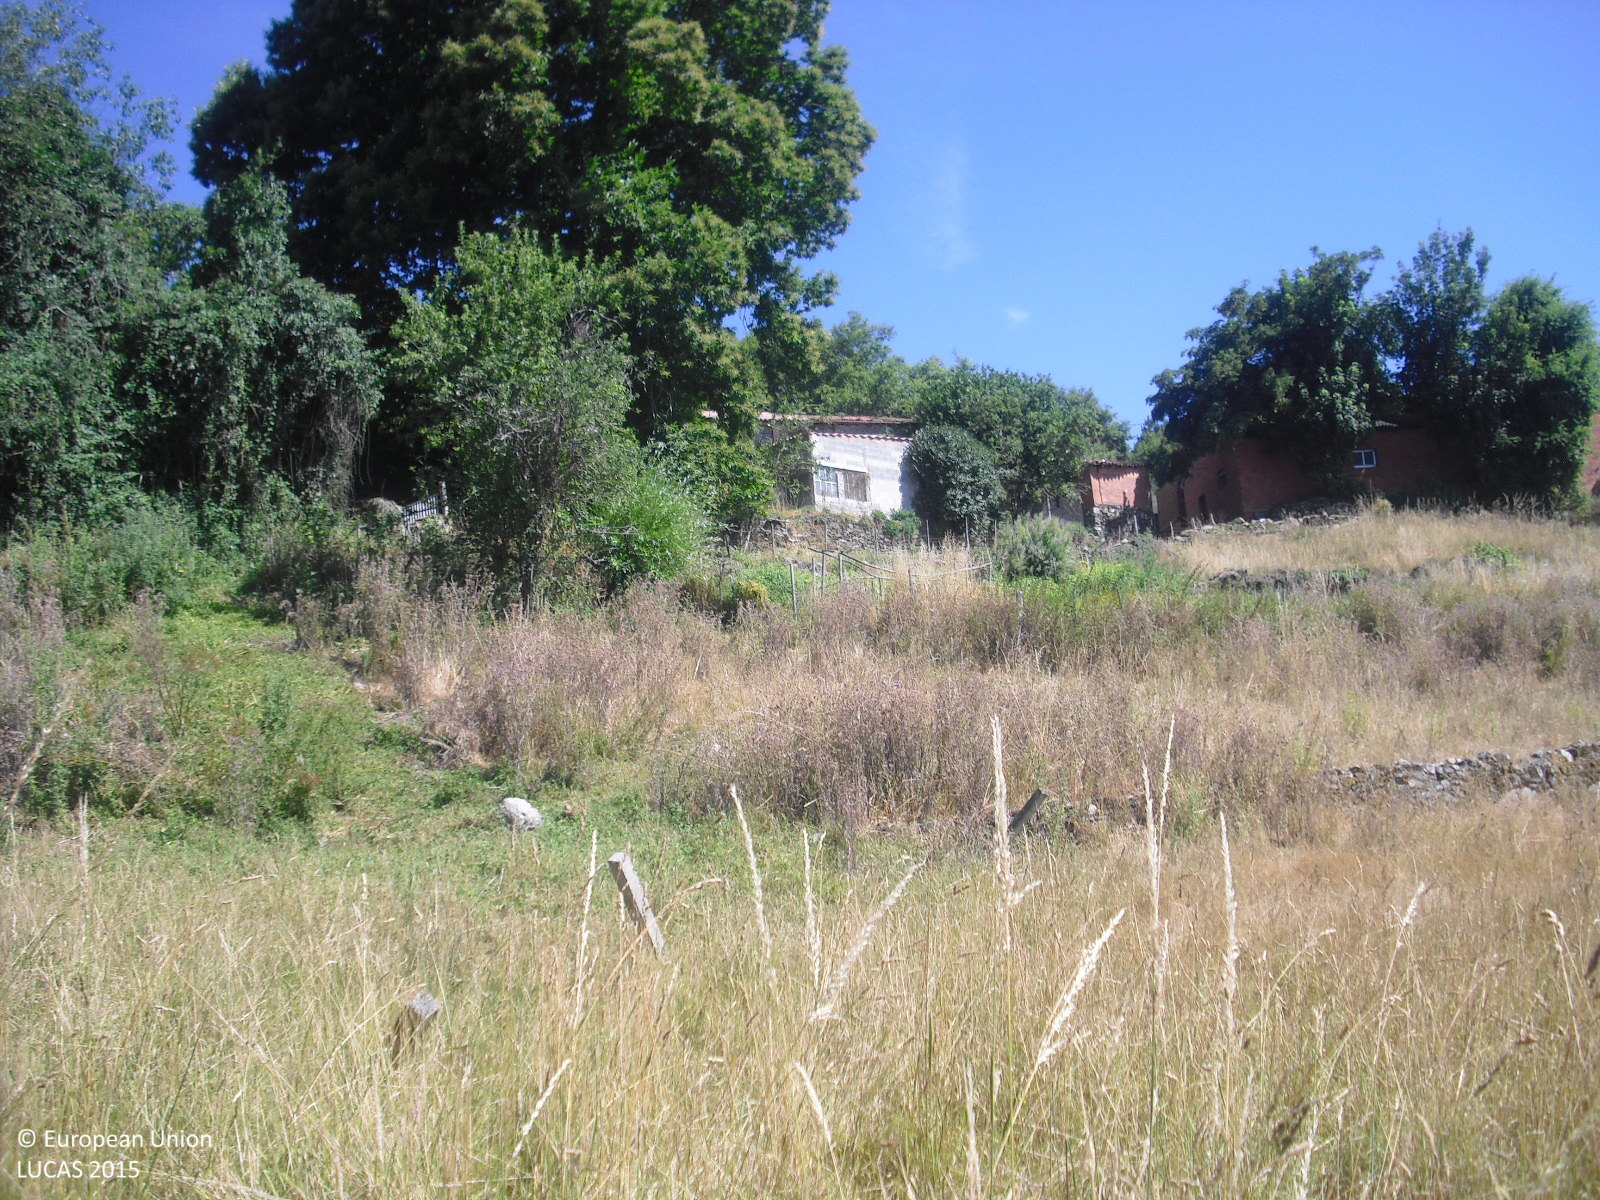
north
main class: Grassland
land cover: Grassland without tree/shrub cover
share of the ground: > 75 %
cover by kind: herbaceous plants 100 %
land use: Agriculture (excluding fallow land and kitchen gardens)
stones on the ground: < 10 %
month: July
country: ES
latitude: 42.5736
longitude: -7.7043
